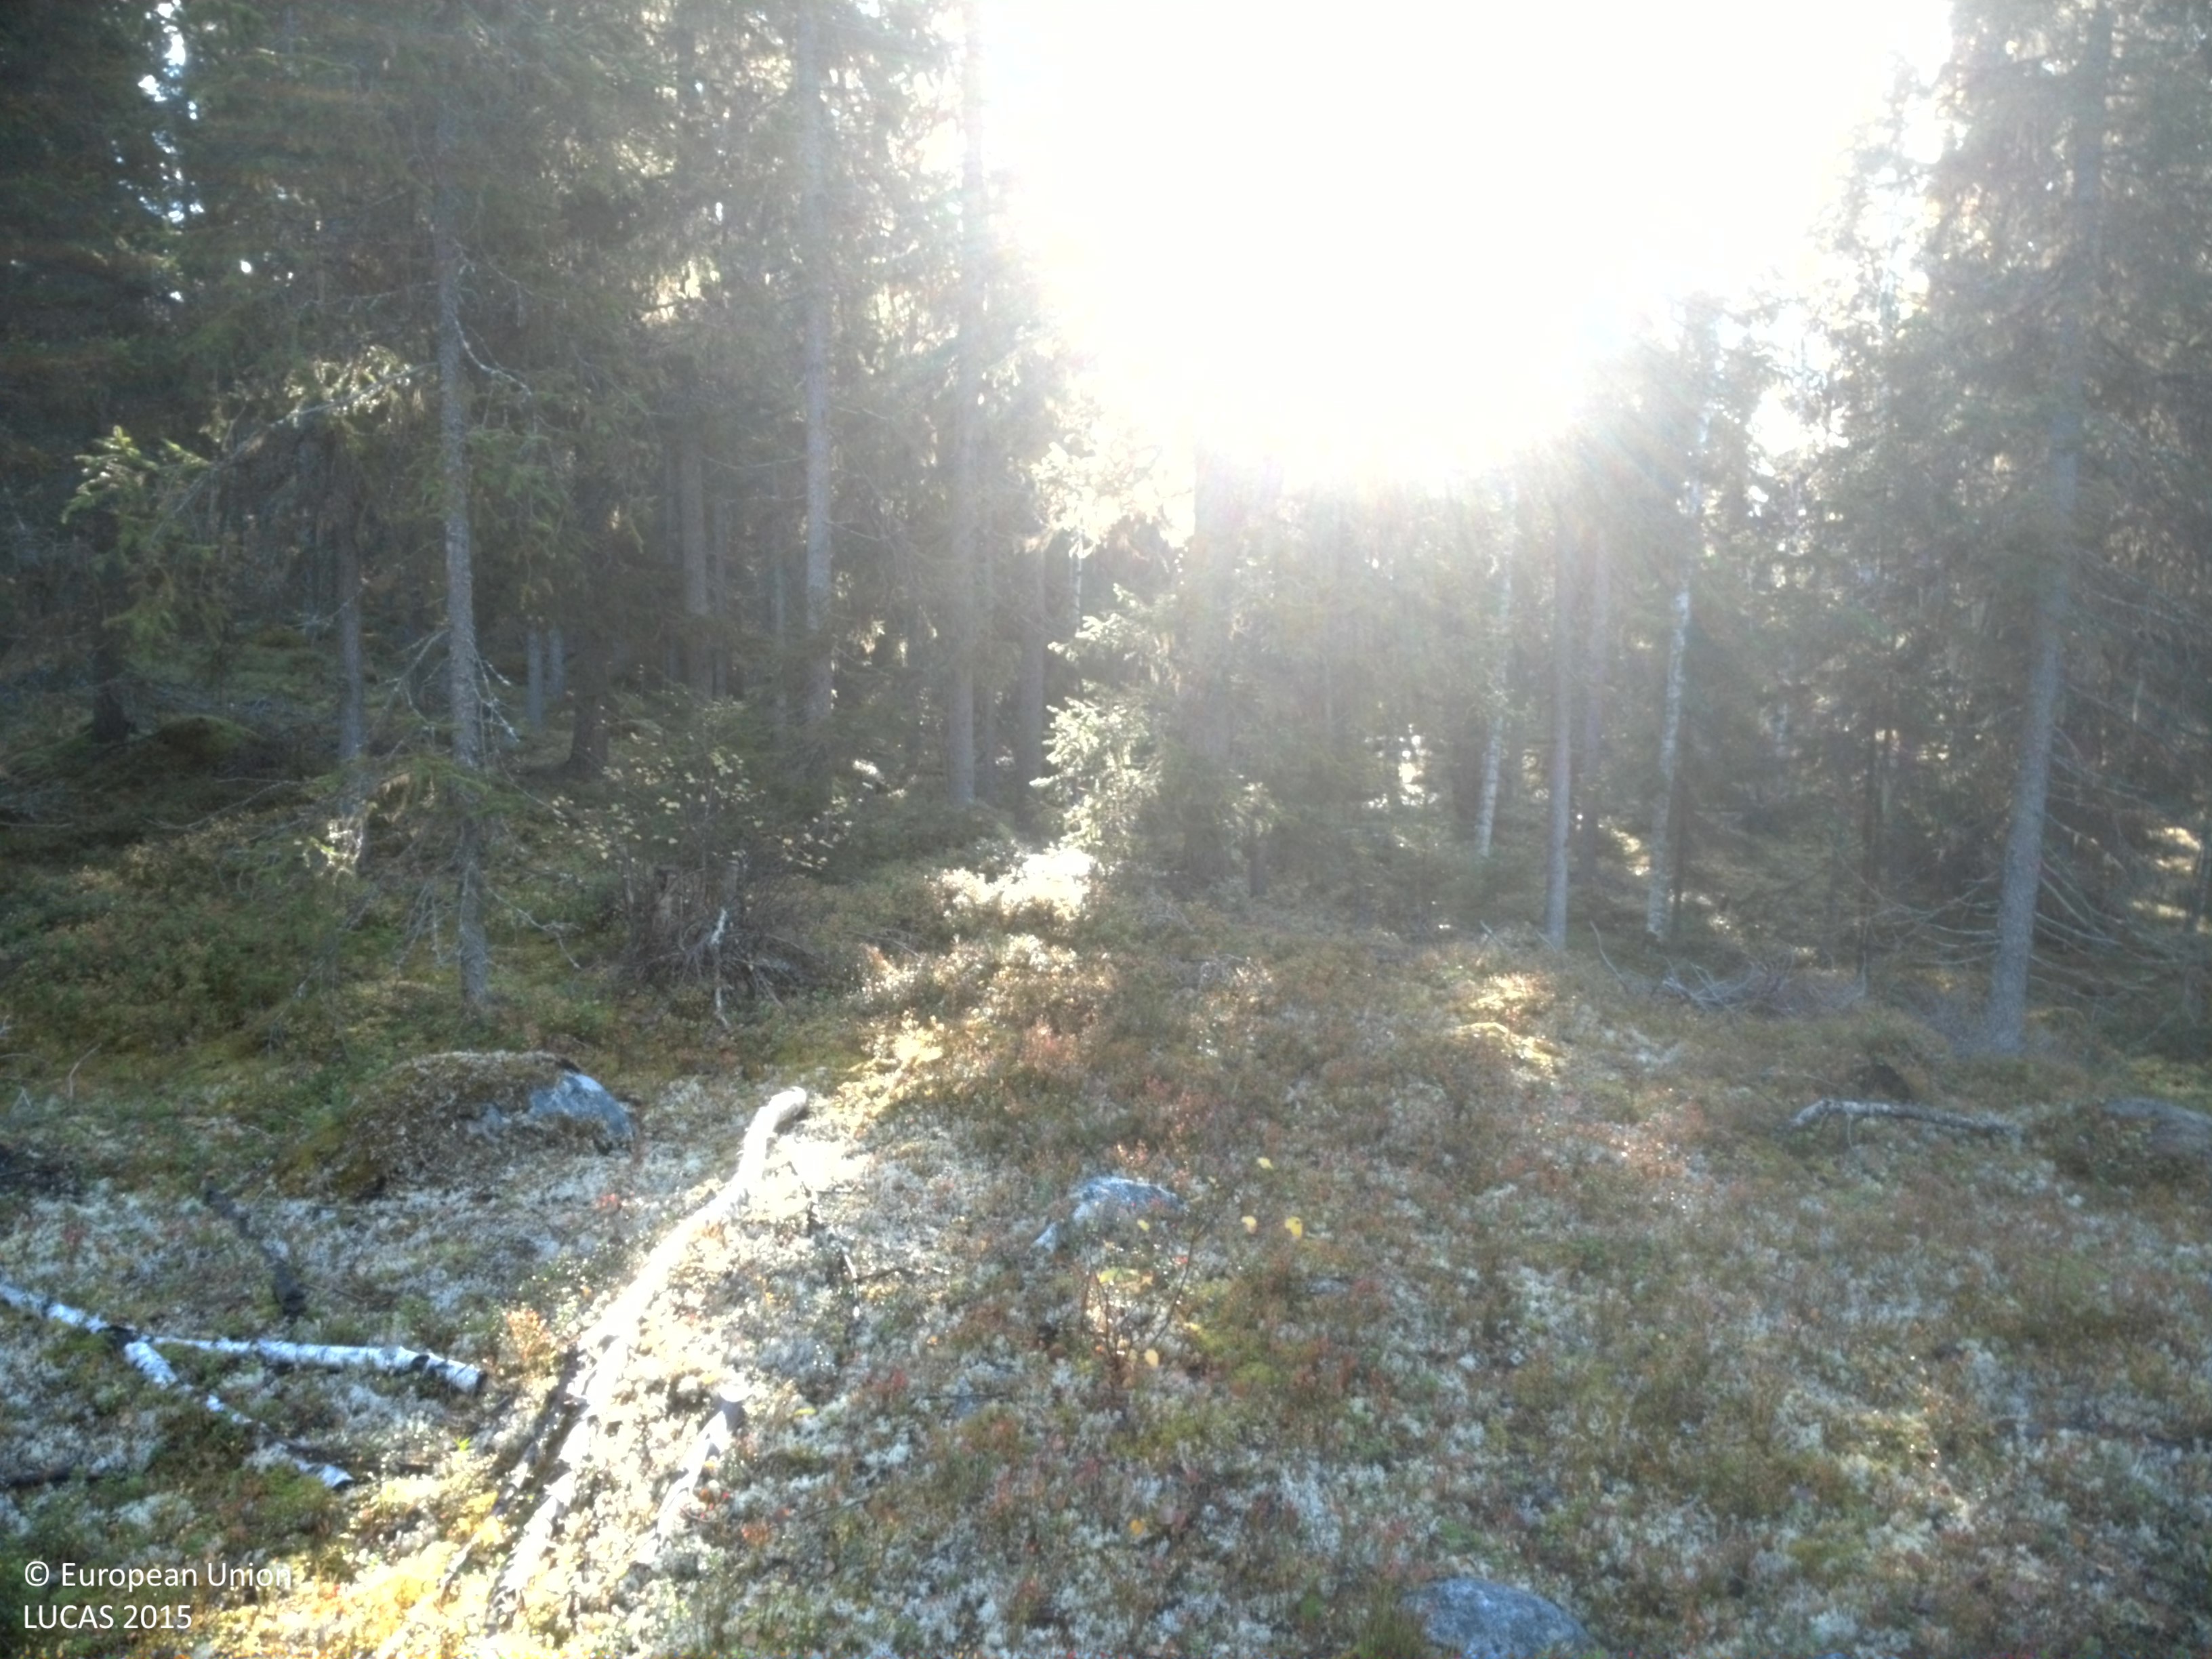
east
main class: Woodland
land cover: Other mixed woodland
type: boreal forest
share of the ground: 50 - 75 %
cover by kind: coniferous forest trees 35 %, shrubs 25 %, broadleaved forest trees 20 %, lichens and mosses 20 %
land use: Forestry
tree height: > 5 m
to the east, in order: Other mixed woodland; Other coniferous woodland; Spruce dominated mixed woodland; Ditches and canals; Other mixed woodland; Spruce dominated mixed woodland; Other mixed woodland
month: September
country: SE
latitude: 64.2089
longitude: 20.0089
